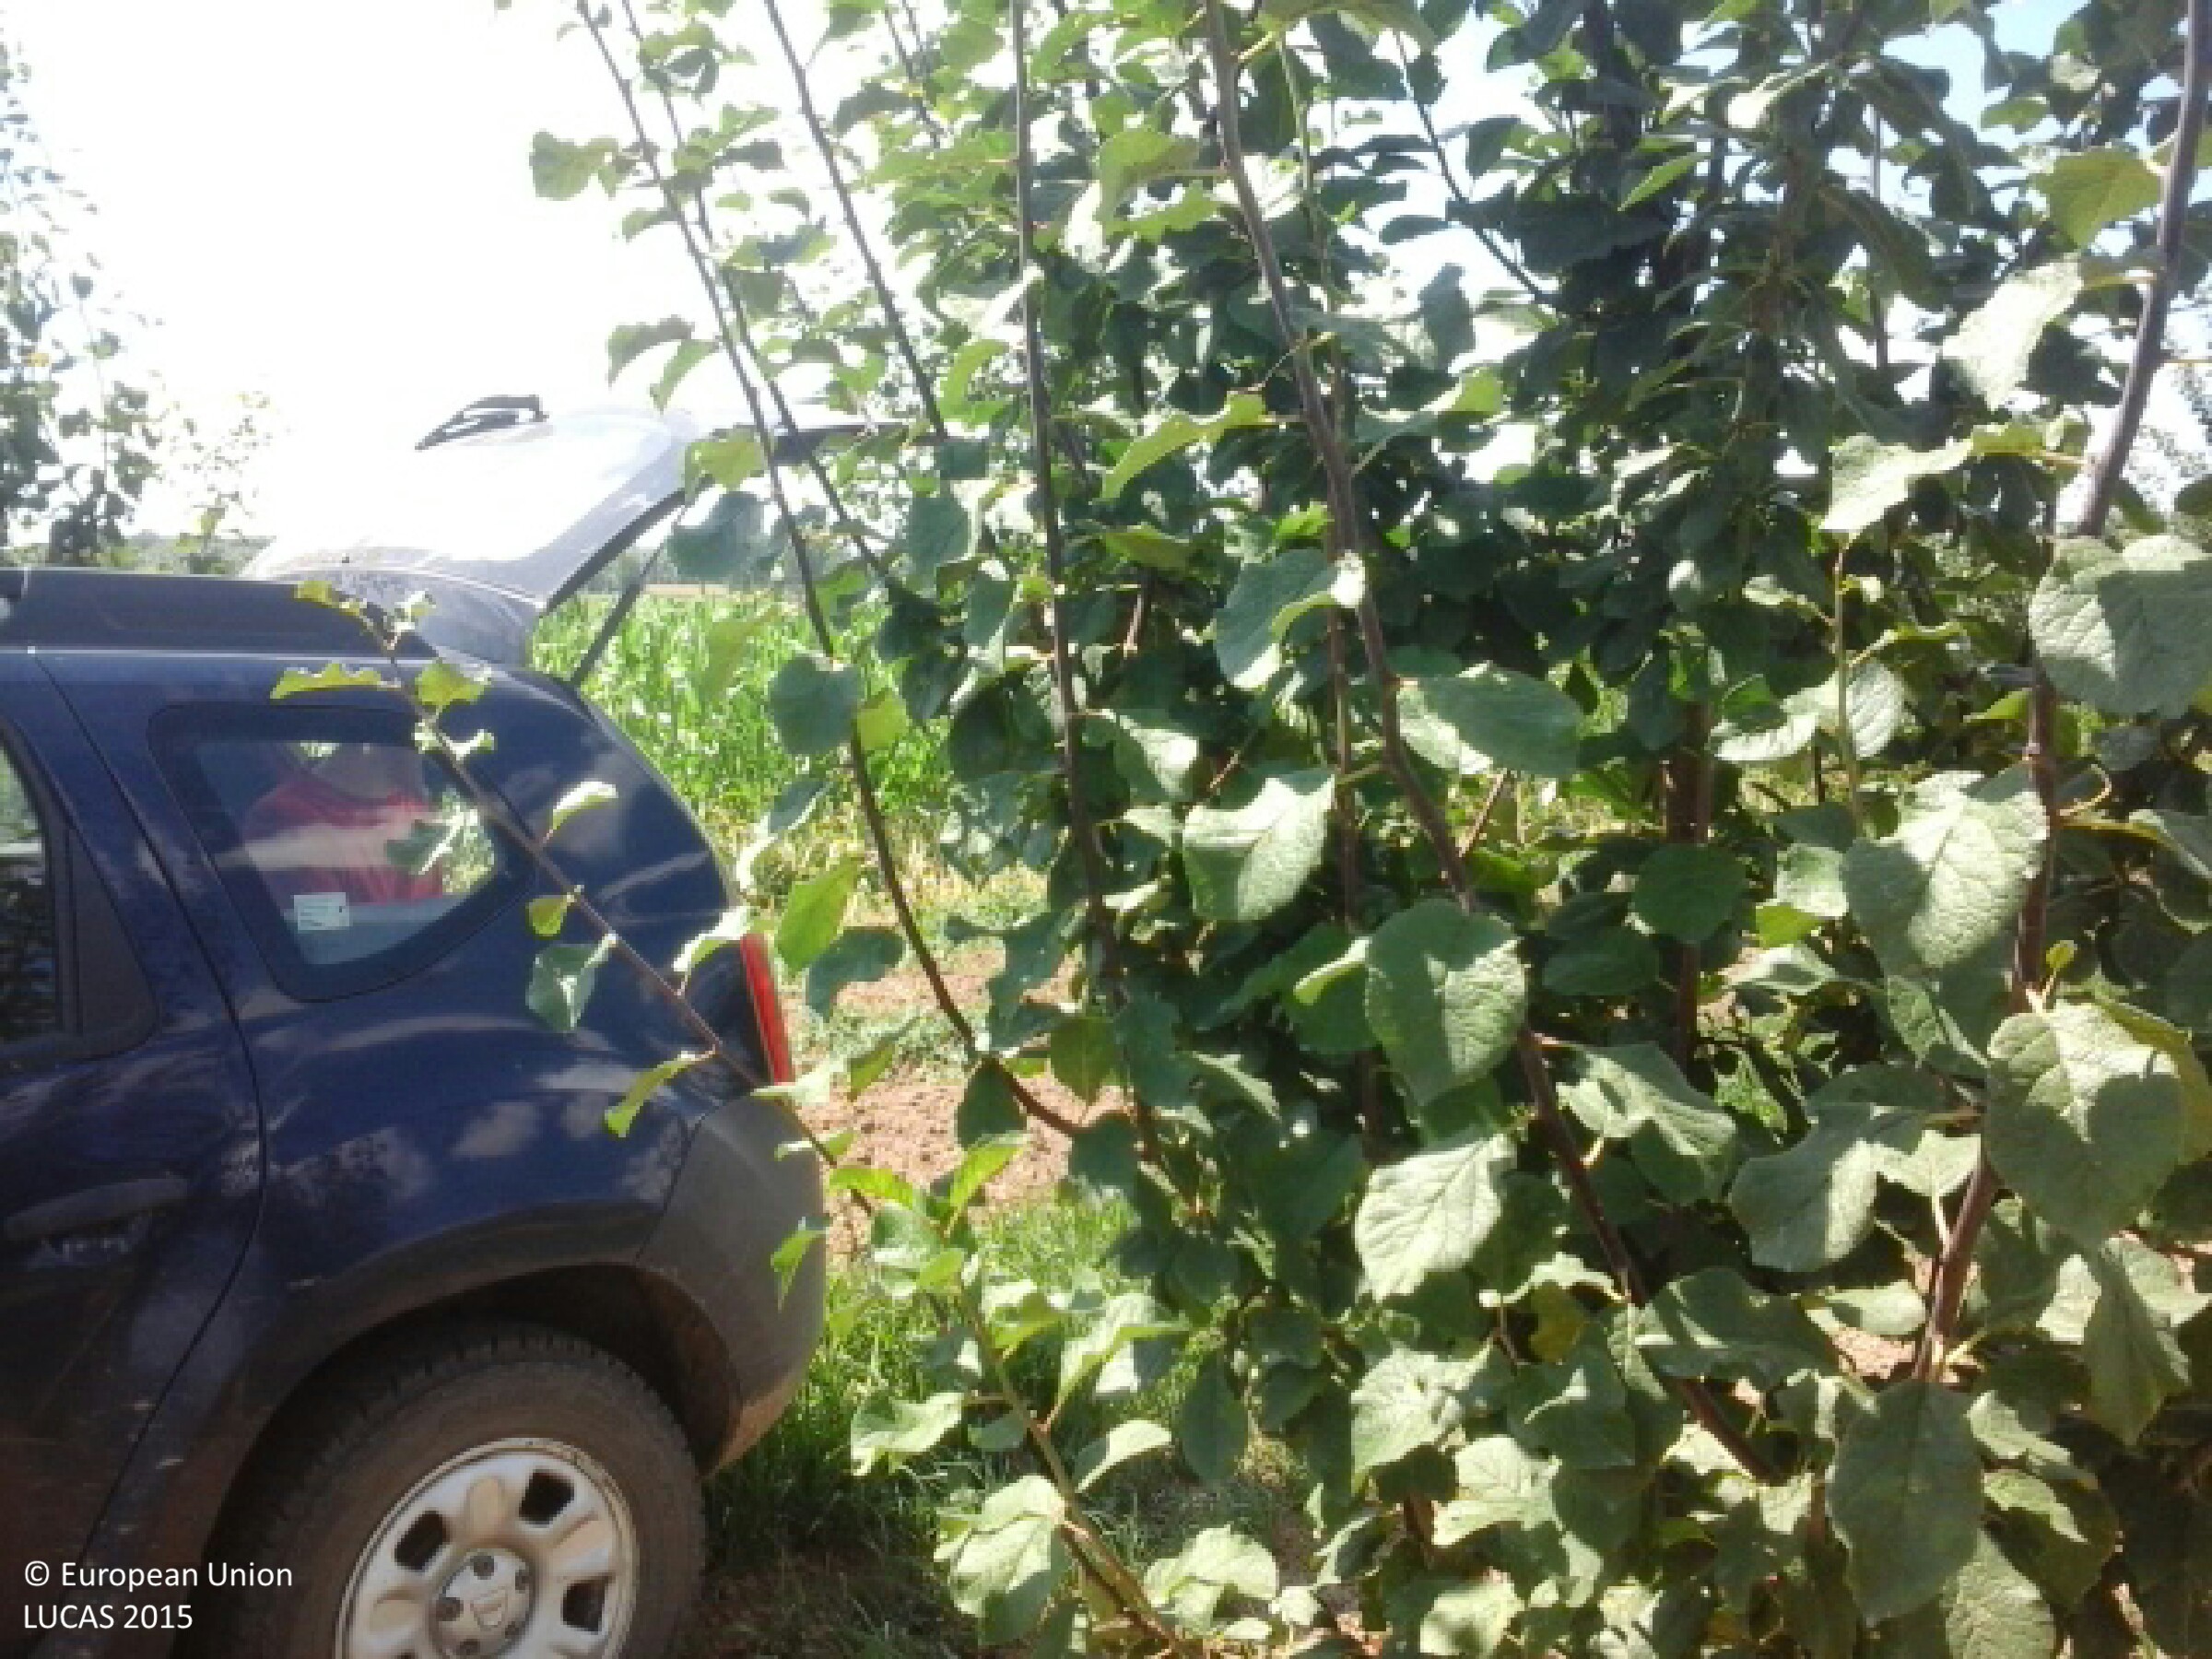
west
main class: Cropland
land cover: Other fruit trees and berries
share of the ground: 10 - 25 %
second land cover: Grassland without tree/shrub cover
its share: > 75 %
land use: Agriculture (excluding fallow land and kitchen gardens)
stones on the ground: < 10 %
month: July
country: HU
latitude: 48.2919
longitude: 22.0090
